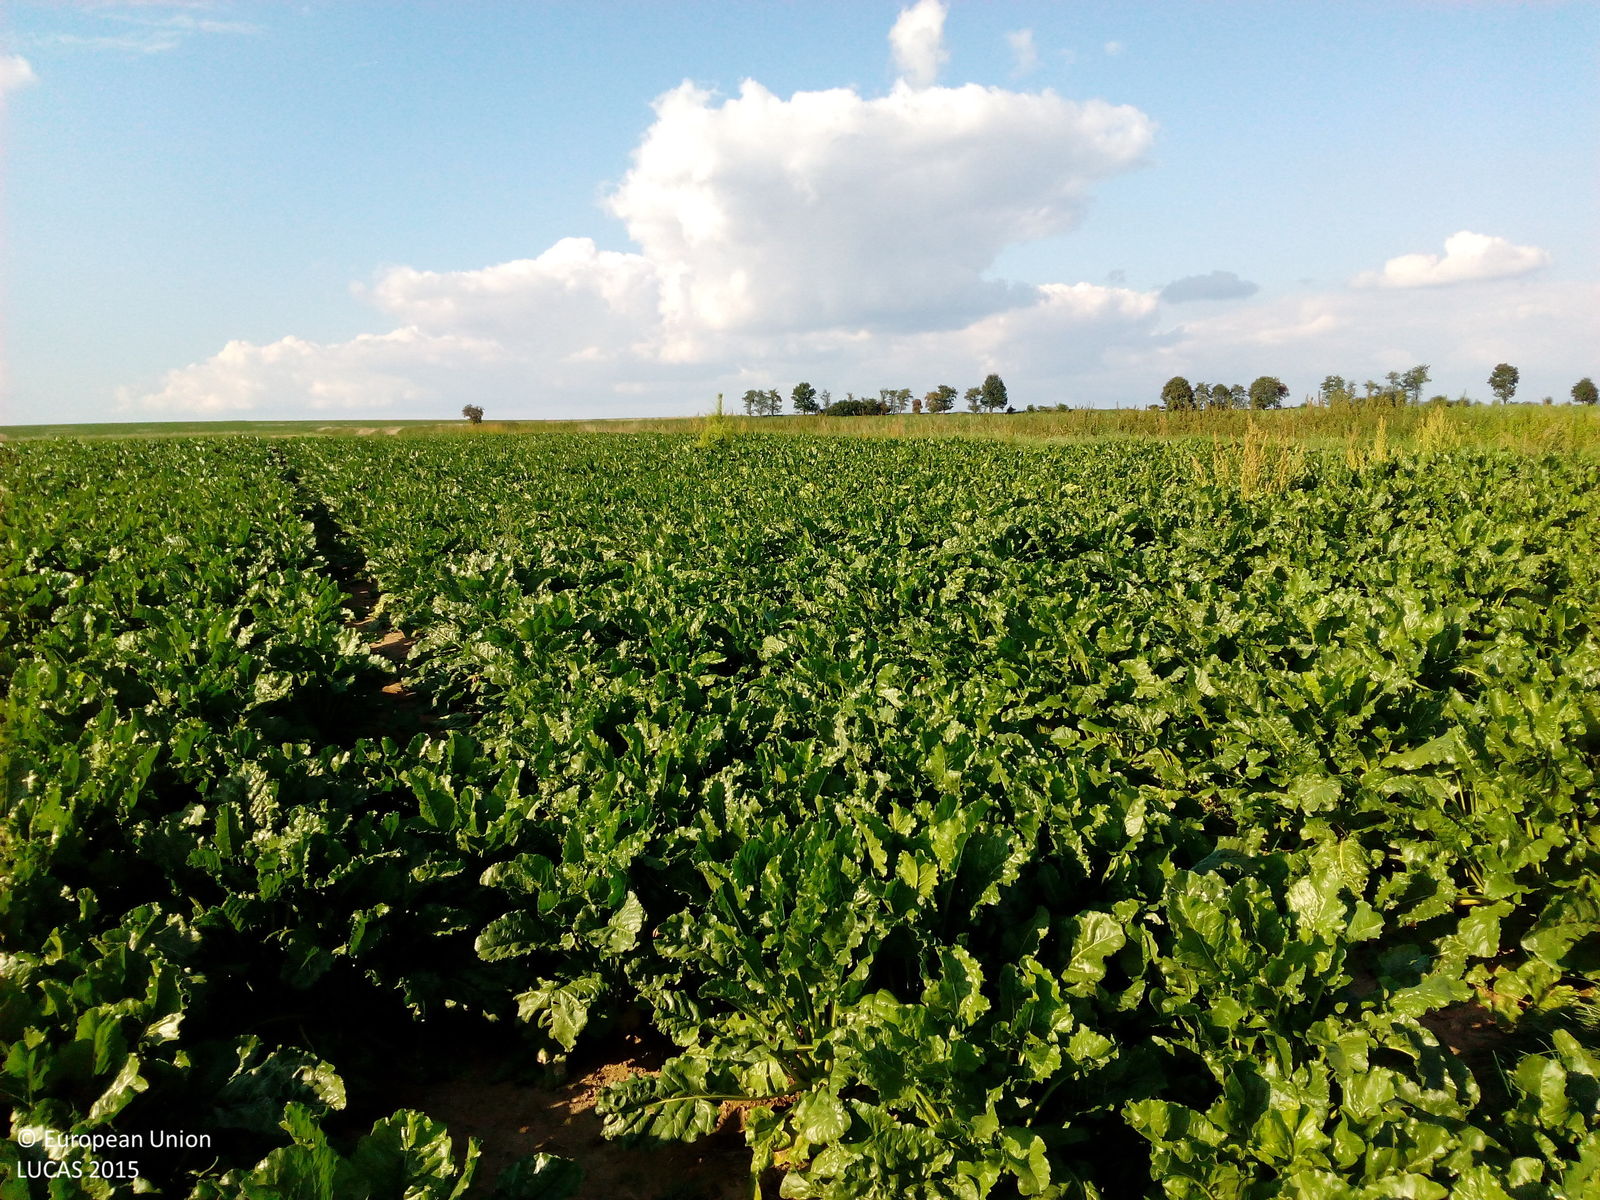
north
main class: Cropland
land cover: Sugar beet
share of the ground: > 75 %
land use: Agriculture (excluding fallow land and kitchen gardens)
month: September
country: DE
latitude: 51.4607
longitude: 9.9568
